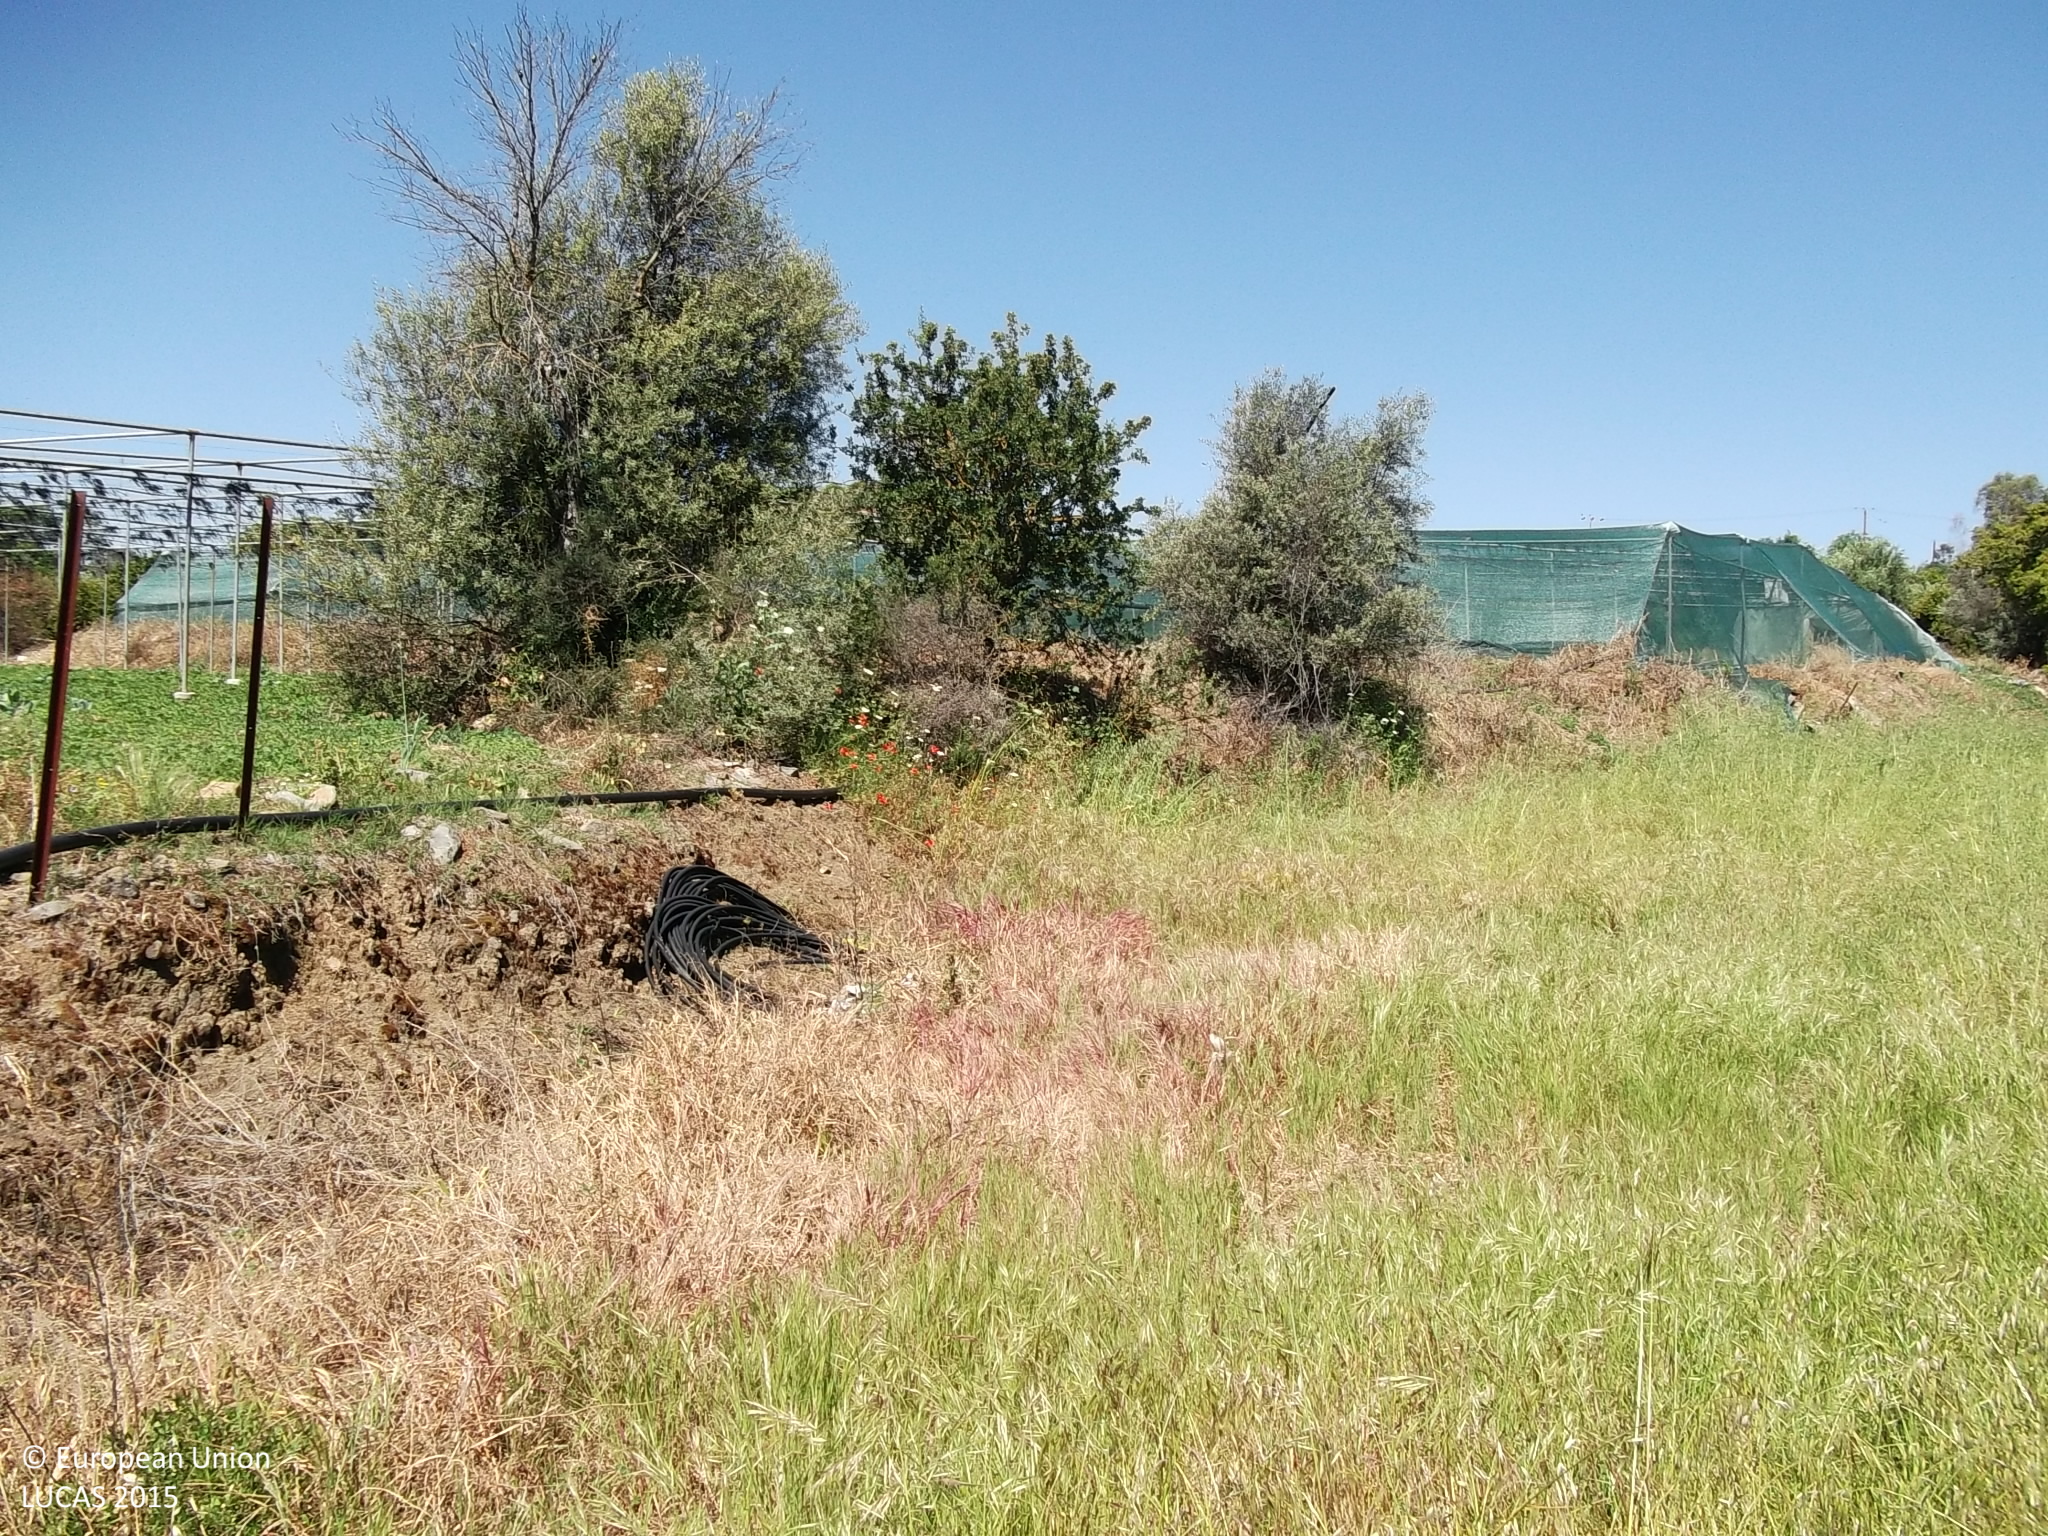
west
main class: Grassland
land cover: Spontaneously vegetated surfaces
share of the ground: > 75 %
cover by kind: herbaceous plants 100 %
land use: Fallow land
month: April
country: CY
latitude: 34.8432
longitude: 33.1737
